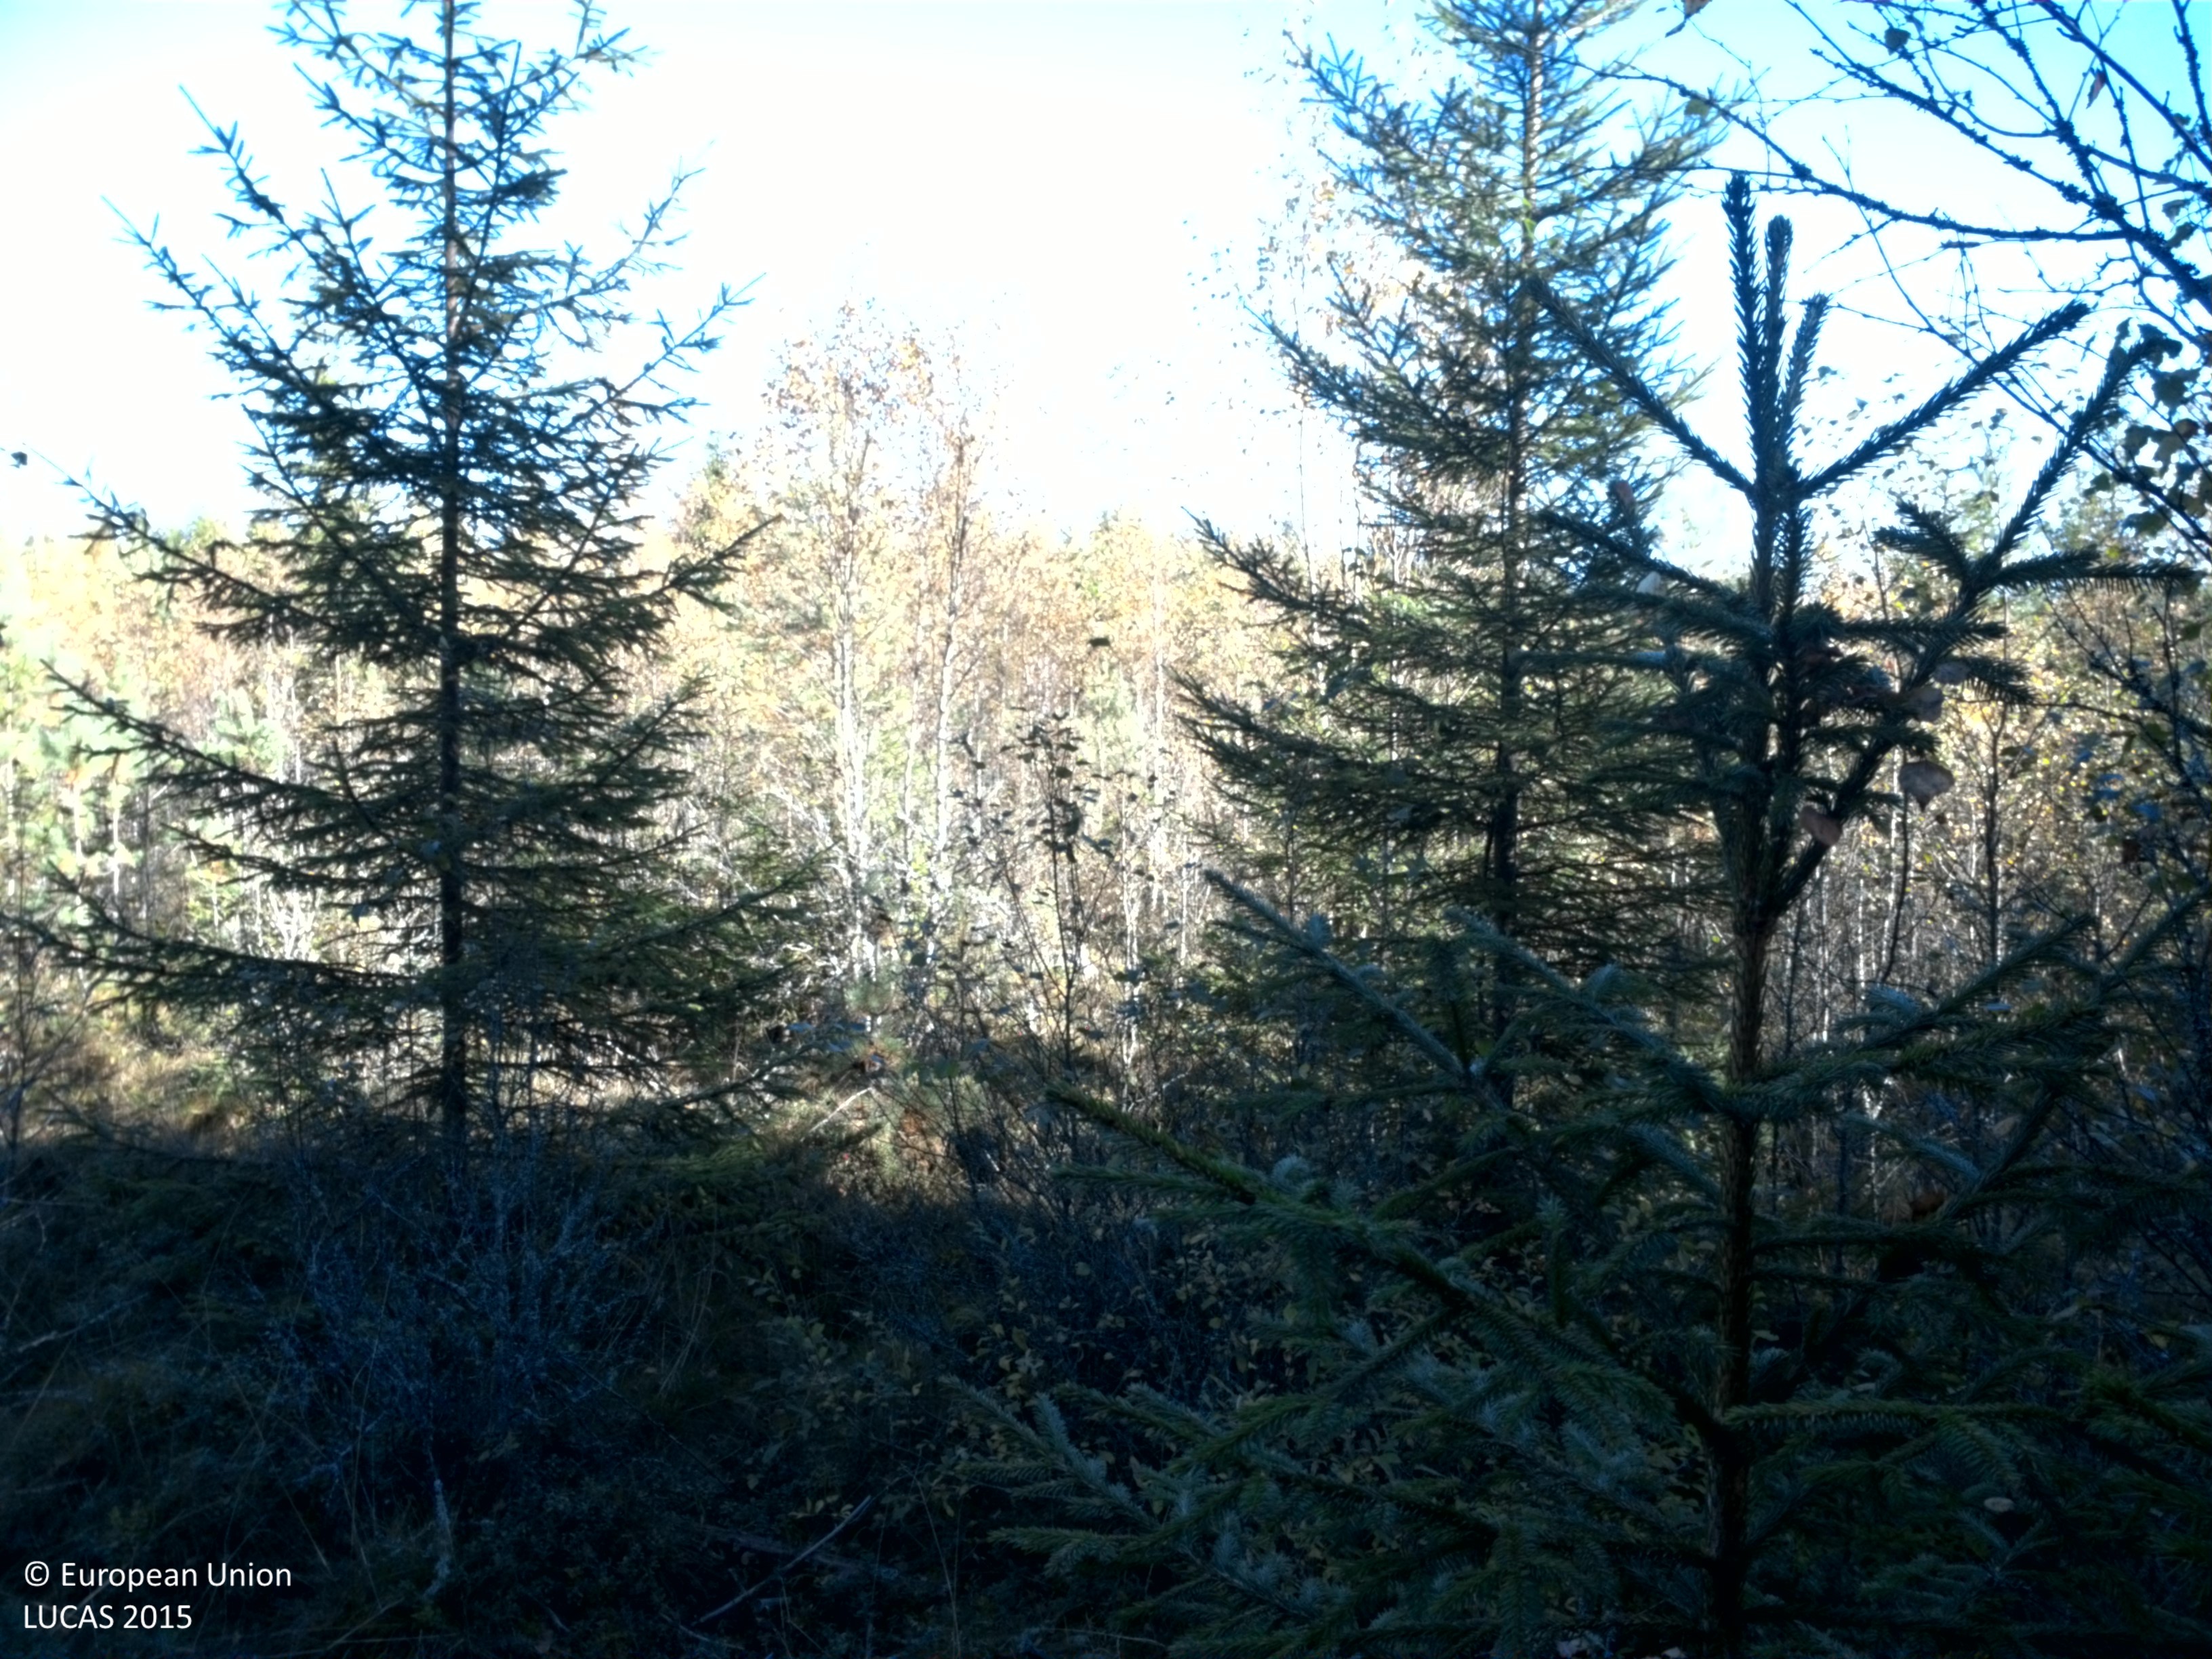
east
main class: Woodland
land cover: Spruce dominated mixed woodland
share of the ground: 10 - 25 %
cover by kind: shrubs 30 %, herbaceous plants 30 %, coniferous forest trees 15 %, lichens and mosses 15 %, broadleaved forest trees 10 %
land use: Forestry
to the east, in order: Spruce dominated mixed woodland; Other mixed woodland; Ditches and canals; Other mixed woodland; Shrubland with sparse tree cover; Spruce dominated coniferous woodland; Other mixed woodland; Pine dominated mixed woodland; Spruce dominated mixed woodland
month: September
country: SE
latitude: 59.1309
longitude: 14.0635
